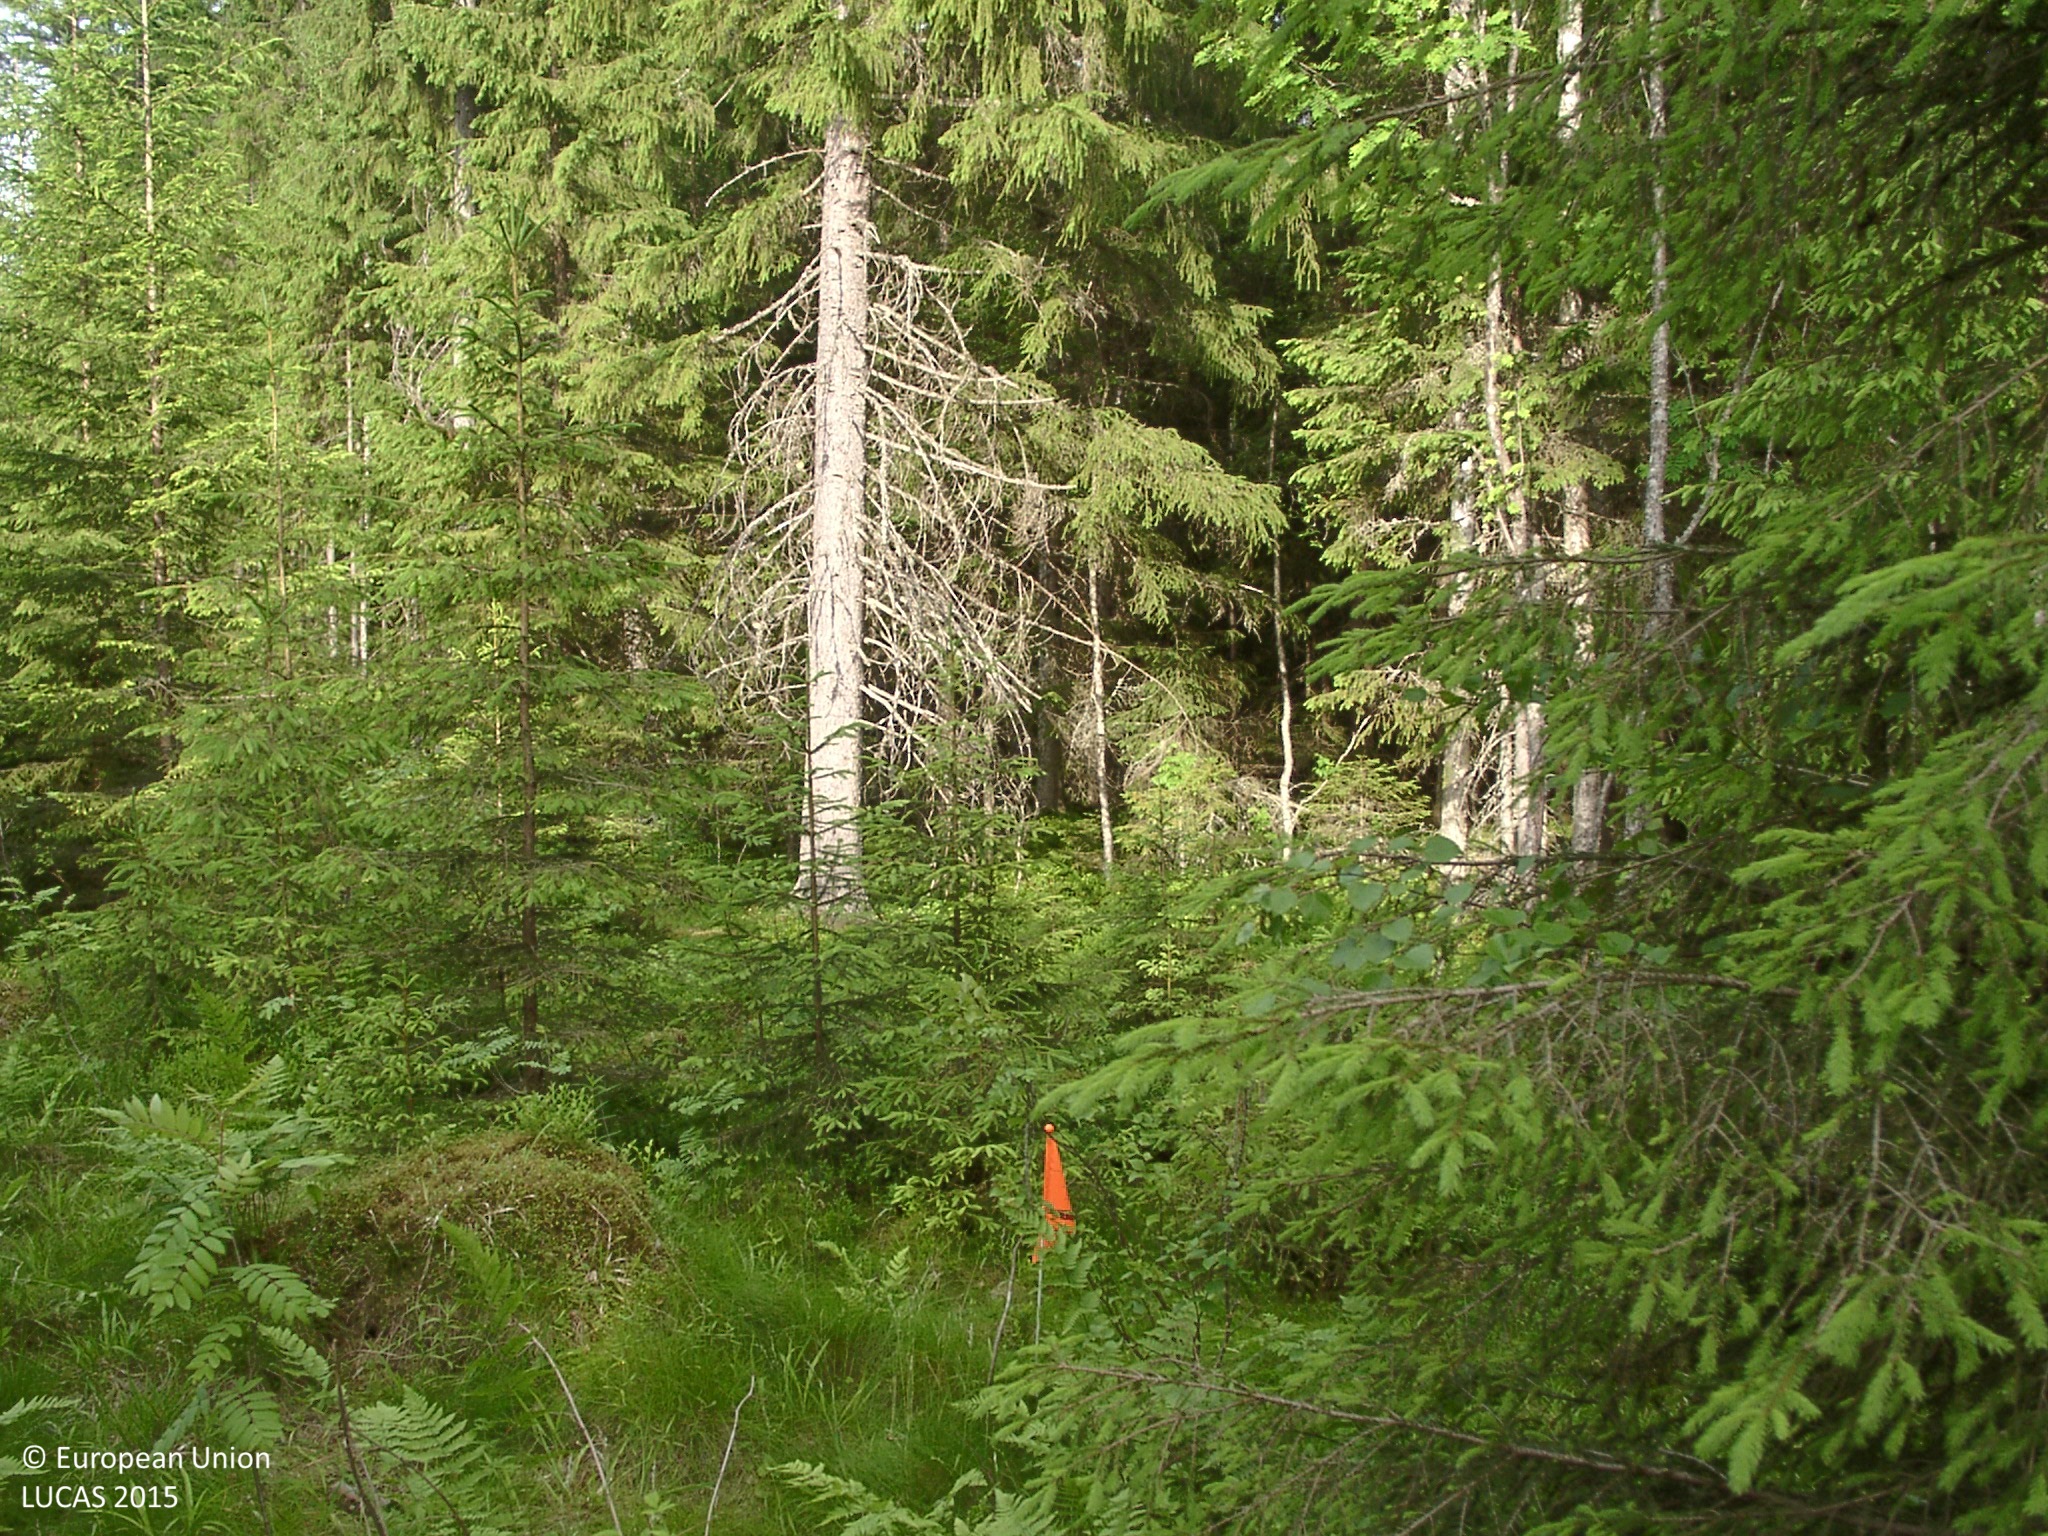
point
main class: Woodland
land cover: Spruce dominated coniferous woodland
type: boreal forest
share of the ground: 50 - 75 %
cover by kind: coniferous forest trees 55 %, shrubs 25 %, herbaceous plants 10 %, broadleaved forest trees 5 %, lichens and mosses 5 %
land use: Forestry
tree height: > 5 m
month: July
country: FI
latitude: 62.0316
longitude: 25.4244
